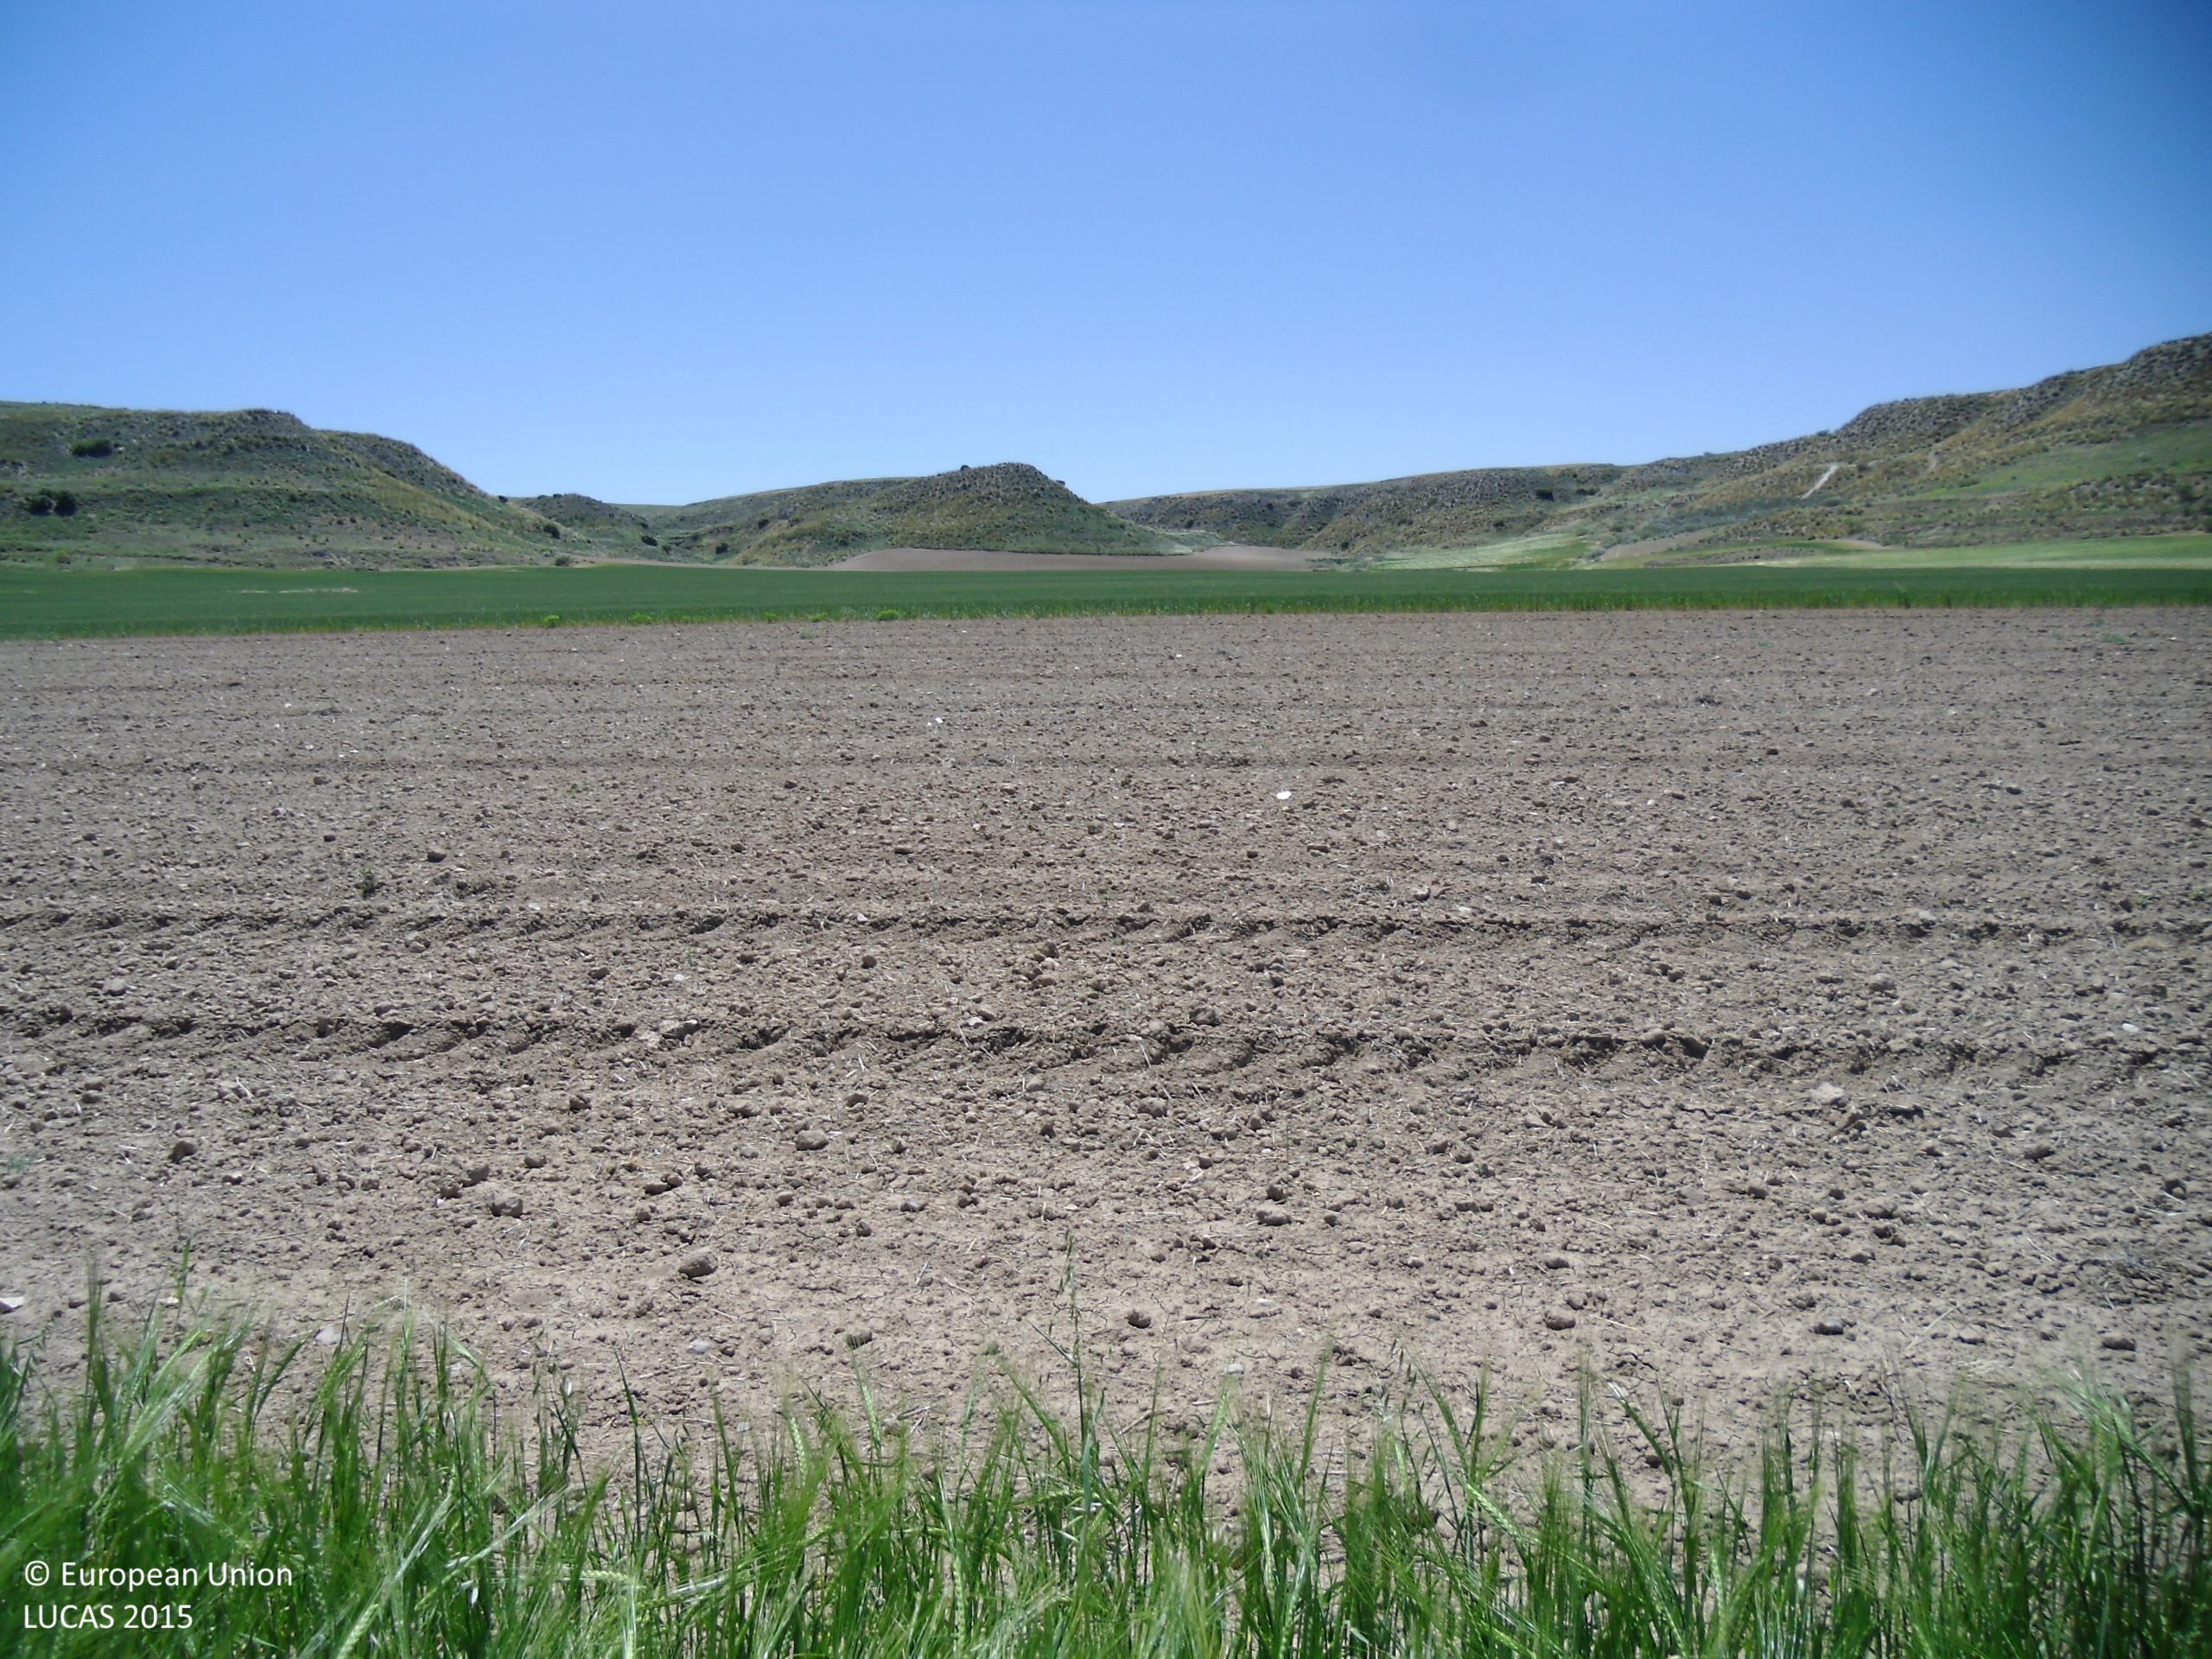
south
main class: Cropland
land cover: Barley
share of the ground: > 75 %
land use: Agriculture (excluding fallow land and kitchen gardens)
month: May
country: ES
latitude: 40.1761
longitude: -2.9311
